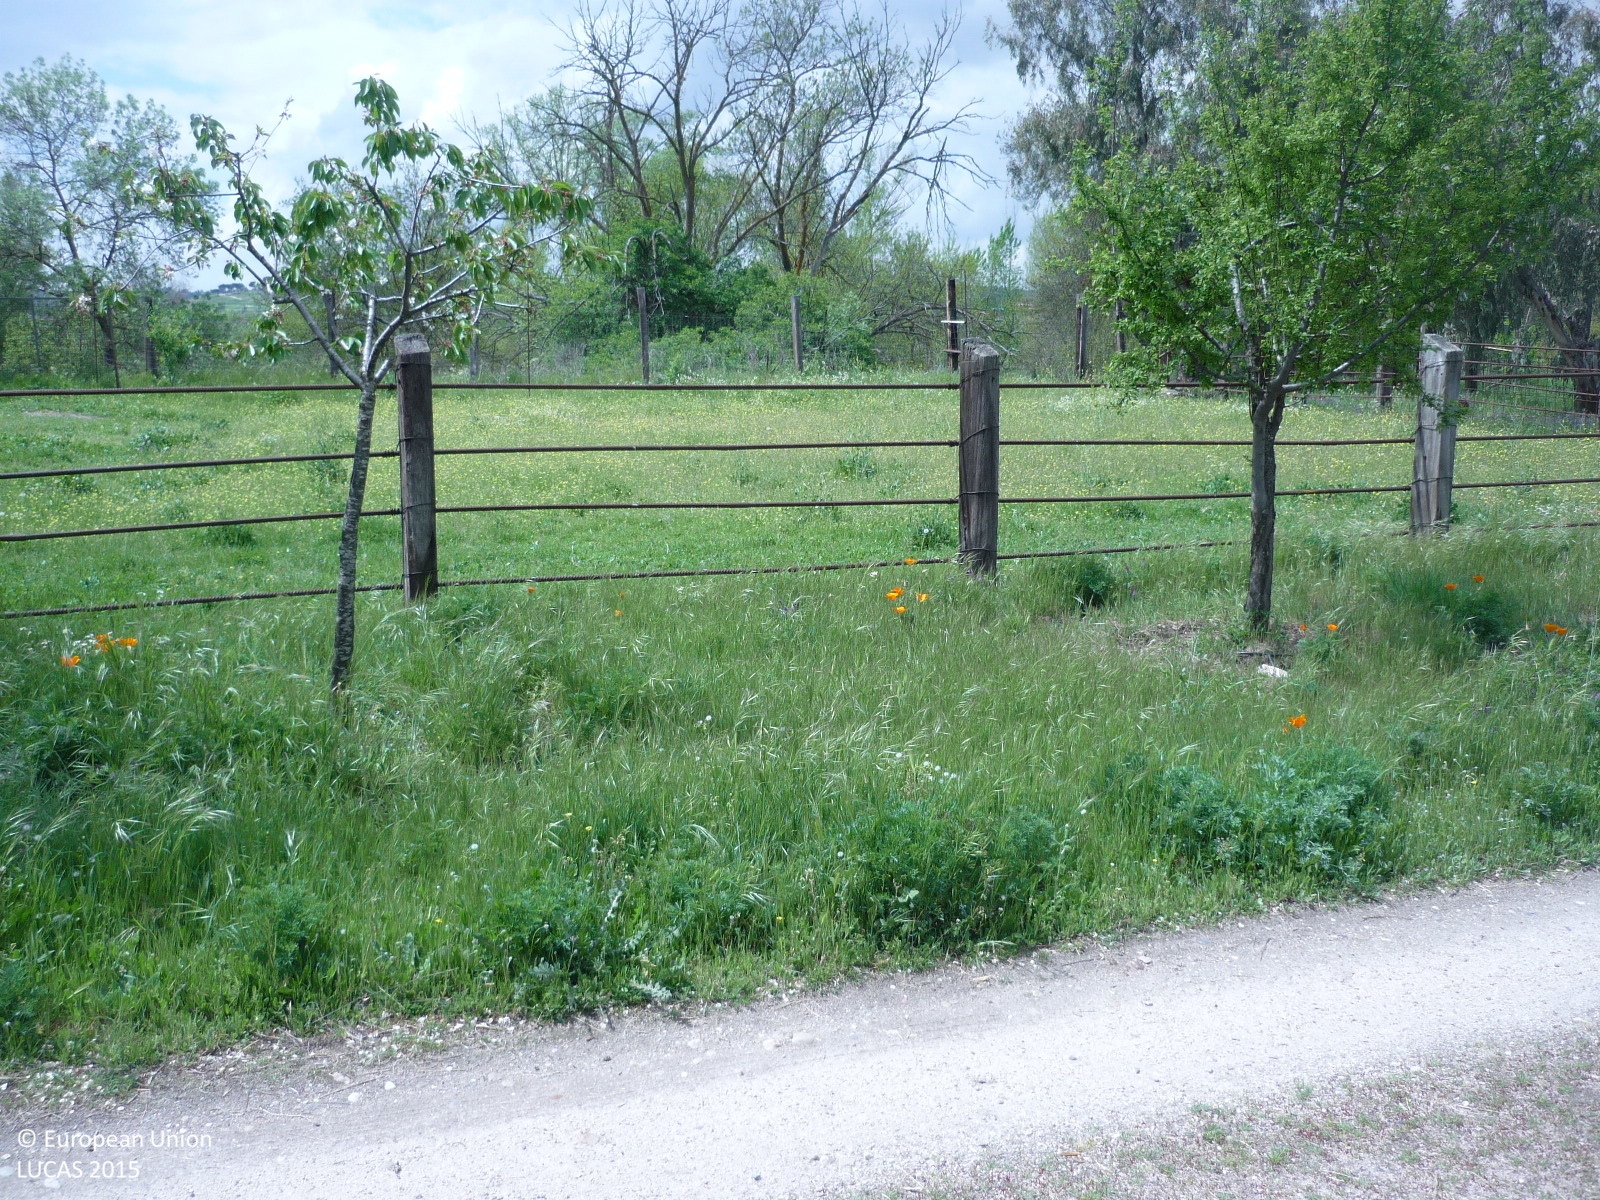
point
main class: Grassland
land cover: Grassland without tree/shrub cover
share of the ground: > 75 %
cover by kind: herbaceous plants 90 %, consolidated bare surface 5 %, unconsolidated bare surface 5 %
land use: Sport
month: April
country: ES
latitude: 40.6195
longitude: -3.5732
